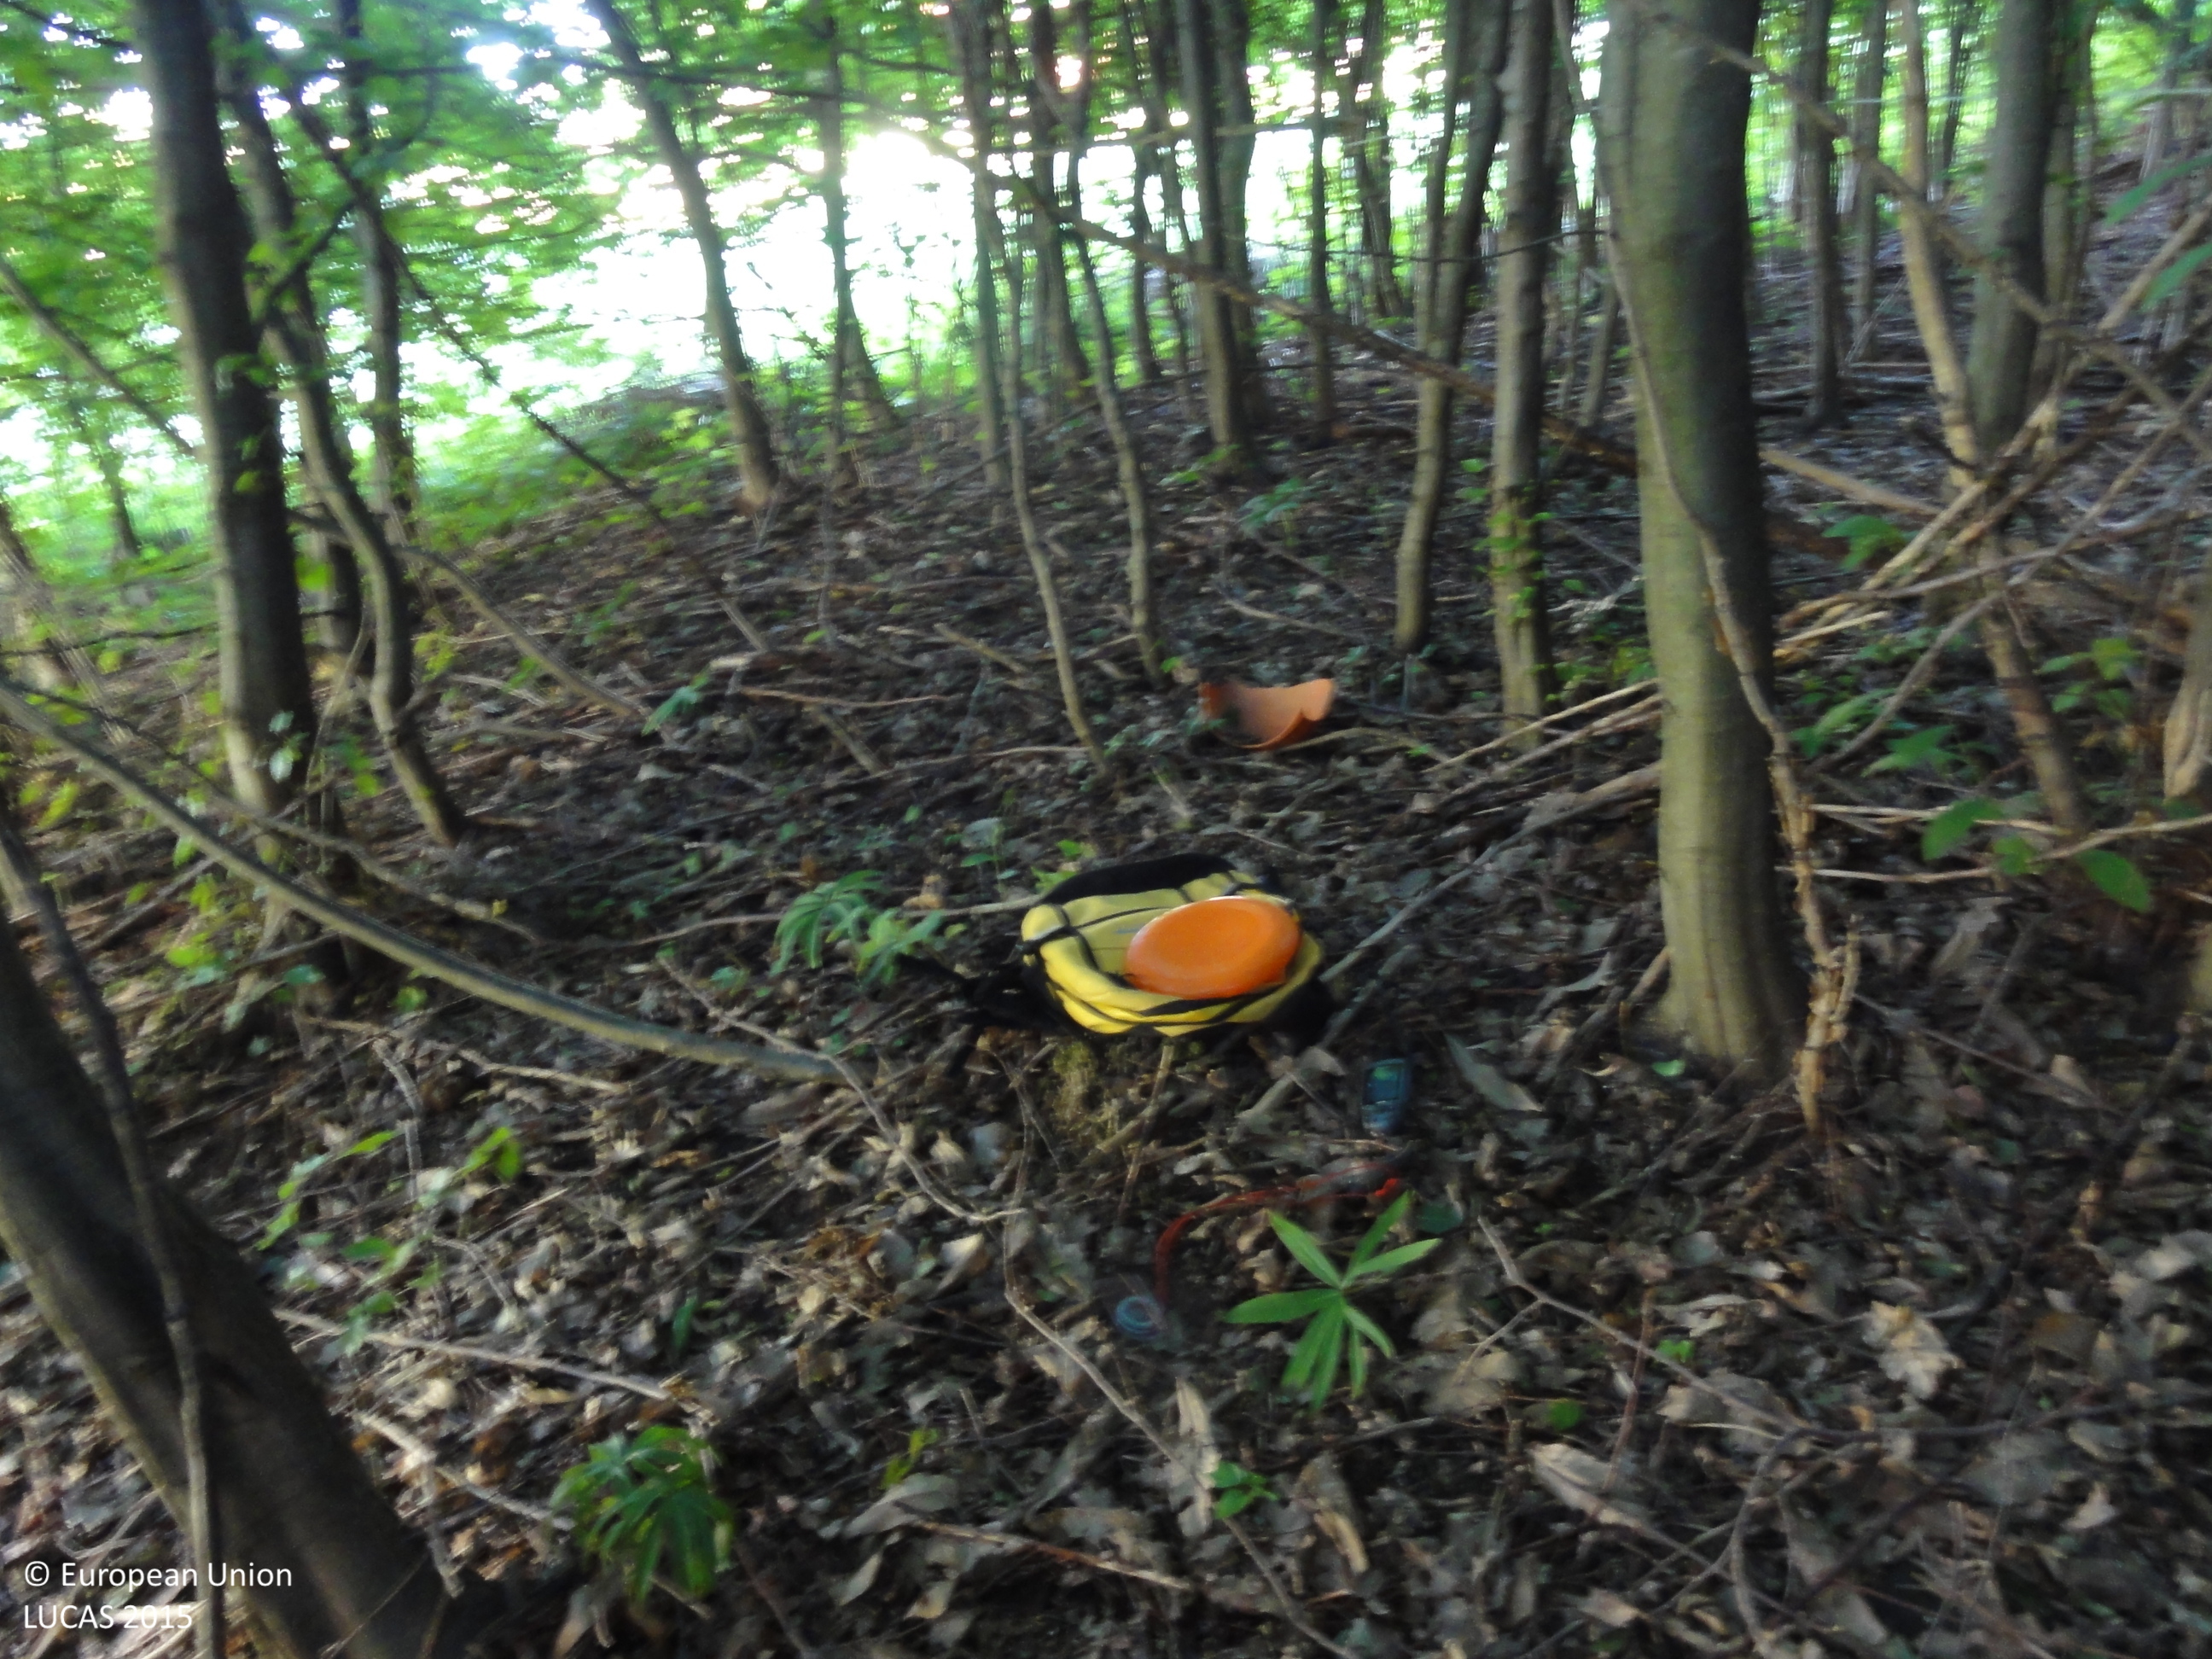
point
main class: Woodland
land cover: Broadleaved woodland
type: mesophytic deciduous forest
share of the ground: > 75 %
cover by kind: broadleaved forest trees 100 %
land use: Forestry
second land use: Amenities, museums, leisure
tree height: > 5 m
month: July
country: SI
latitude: 46.3222
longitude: 15.0499
